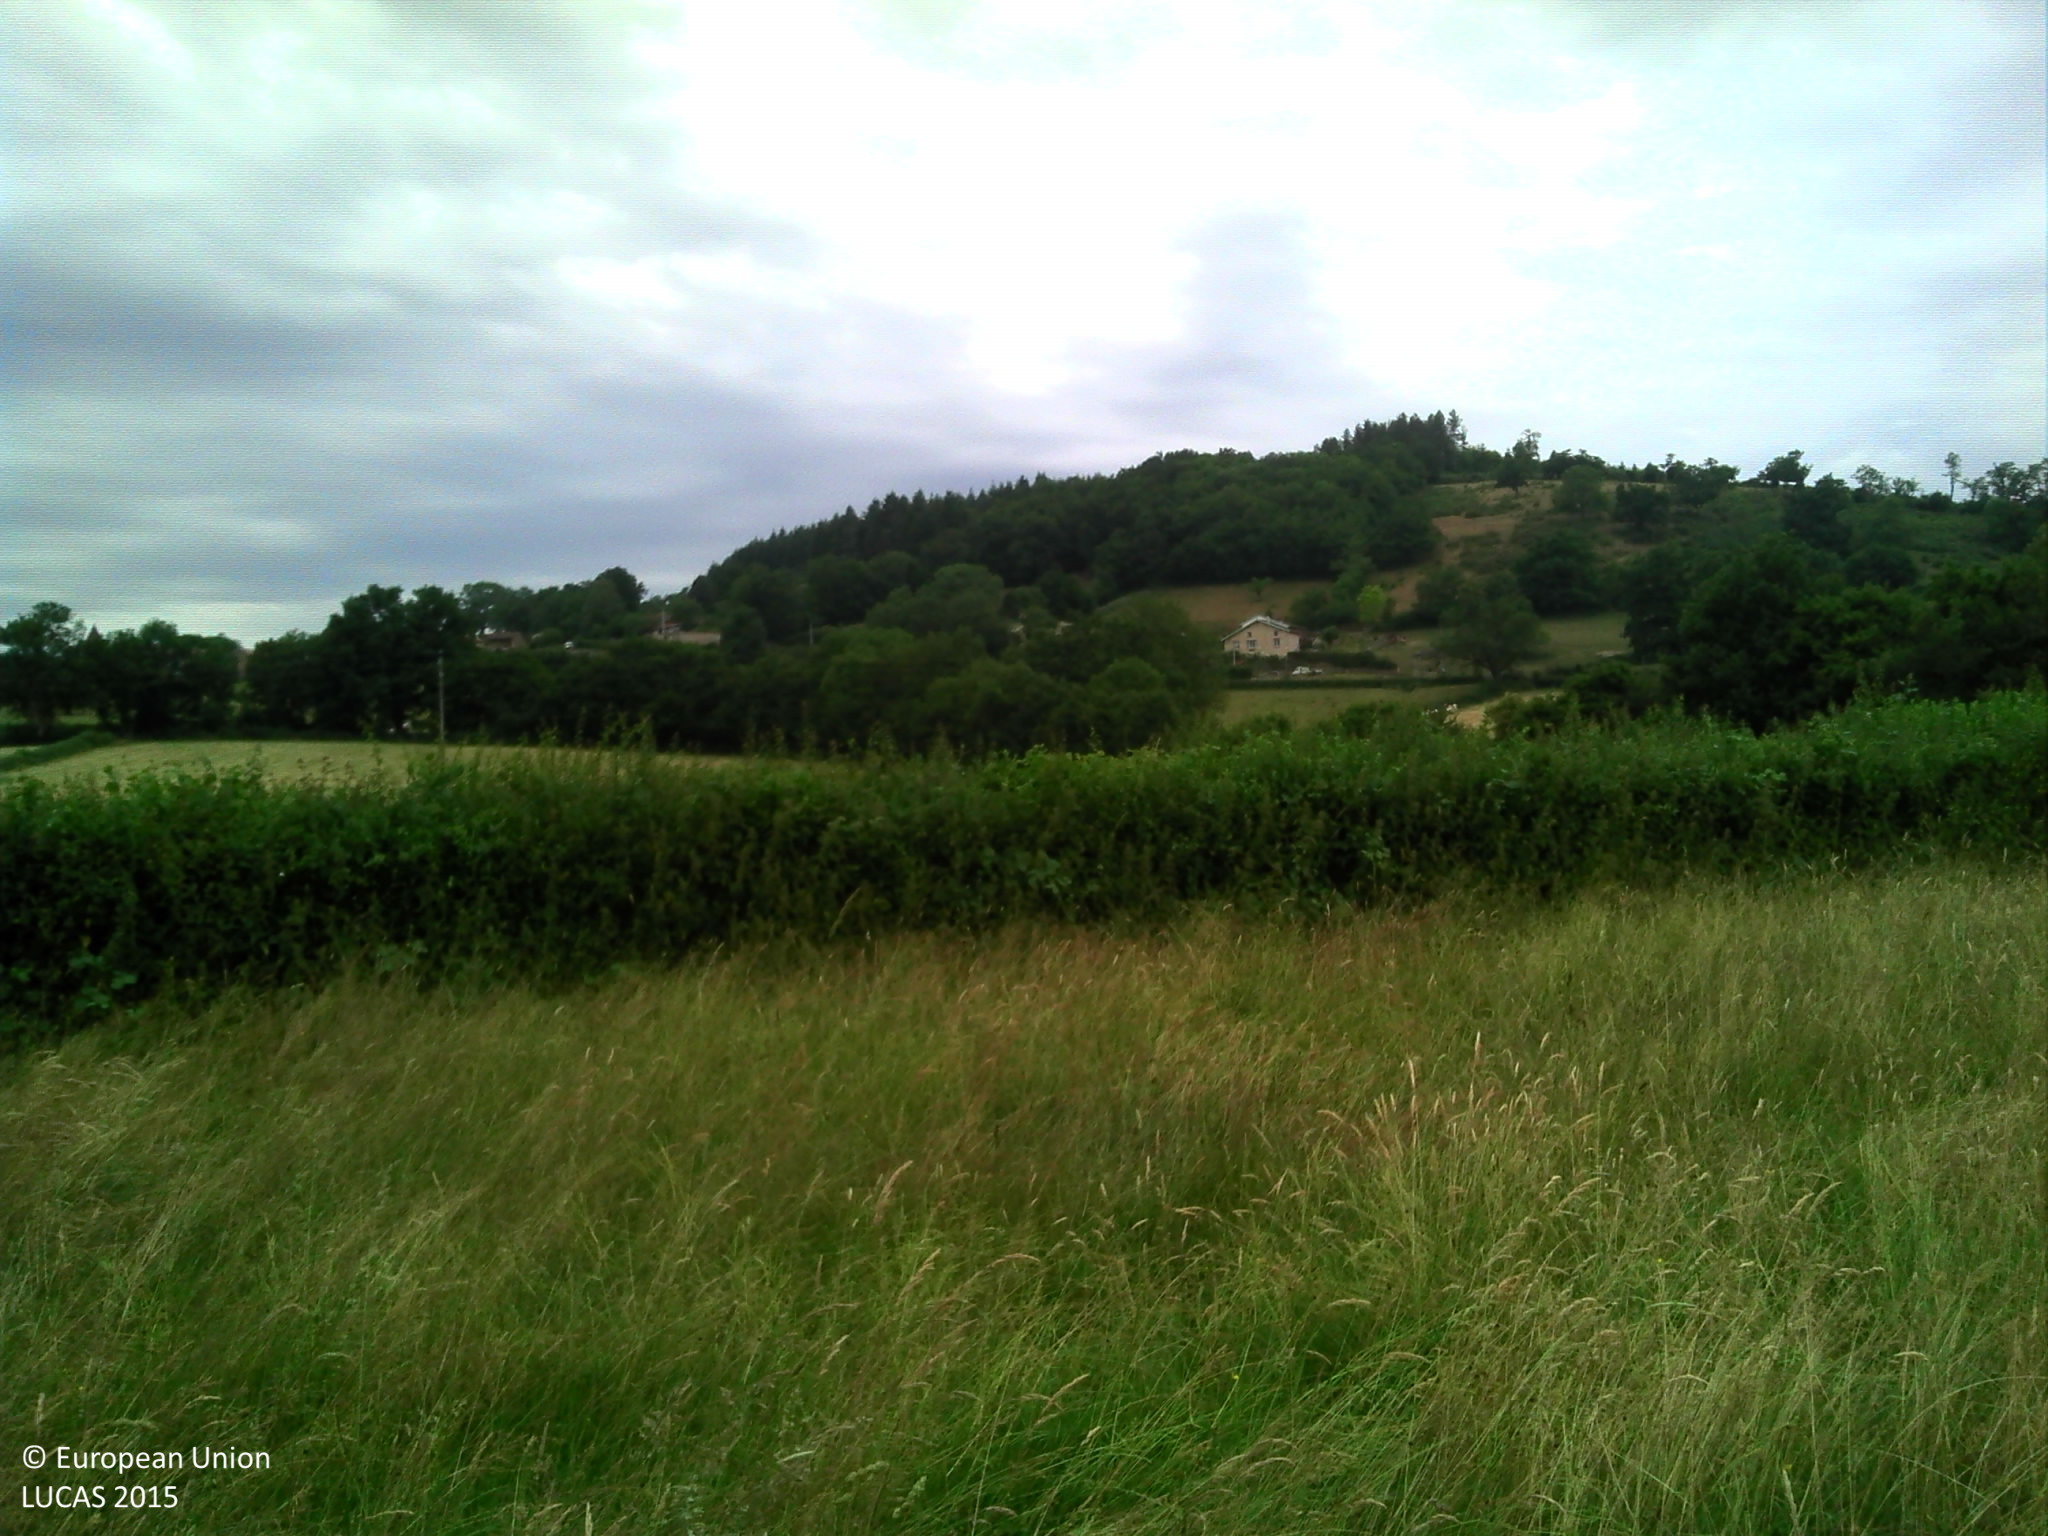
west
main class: Grassland
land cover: Grassland without tree/shrub cover
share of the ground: > 75 %
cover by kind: herbaceous plants 100 %
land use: Agriculture (excluding fallow land and kitchen gardens)
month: June
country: FR
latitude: 46.3570
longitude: 4.5563
